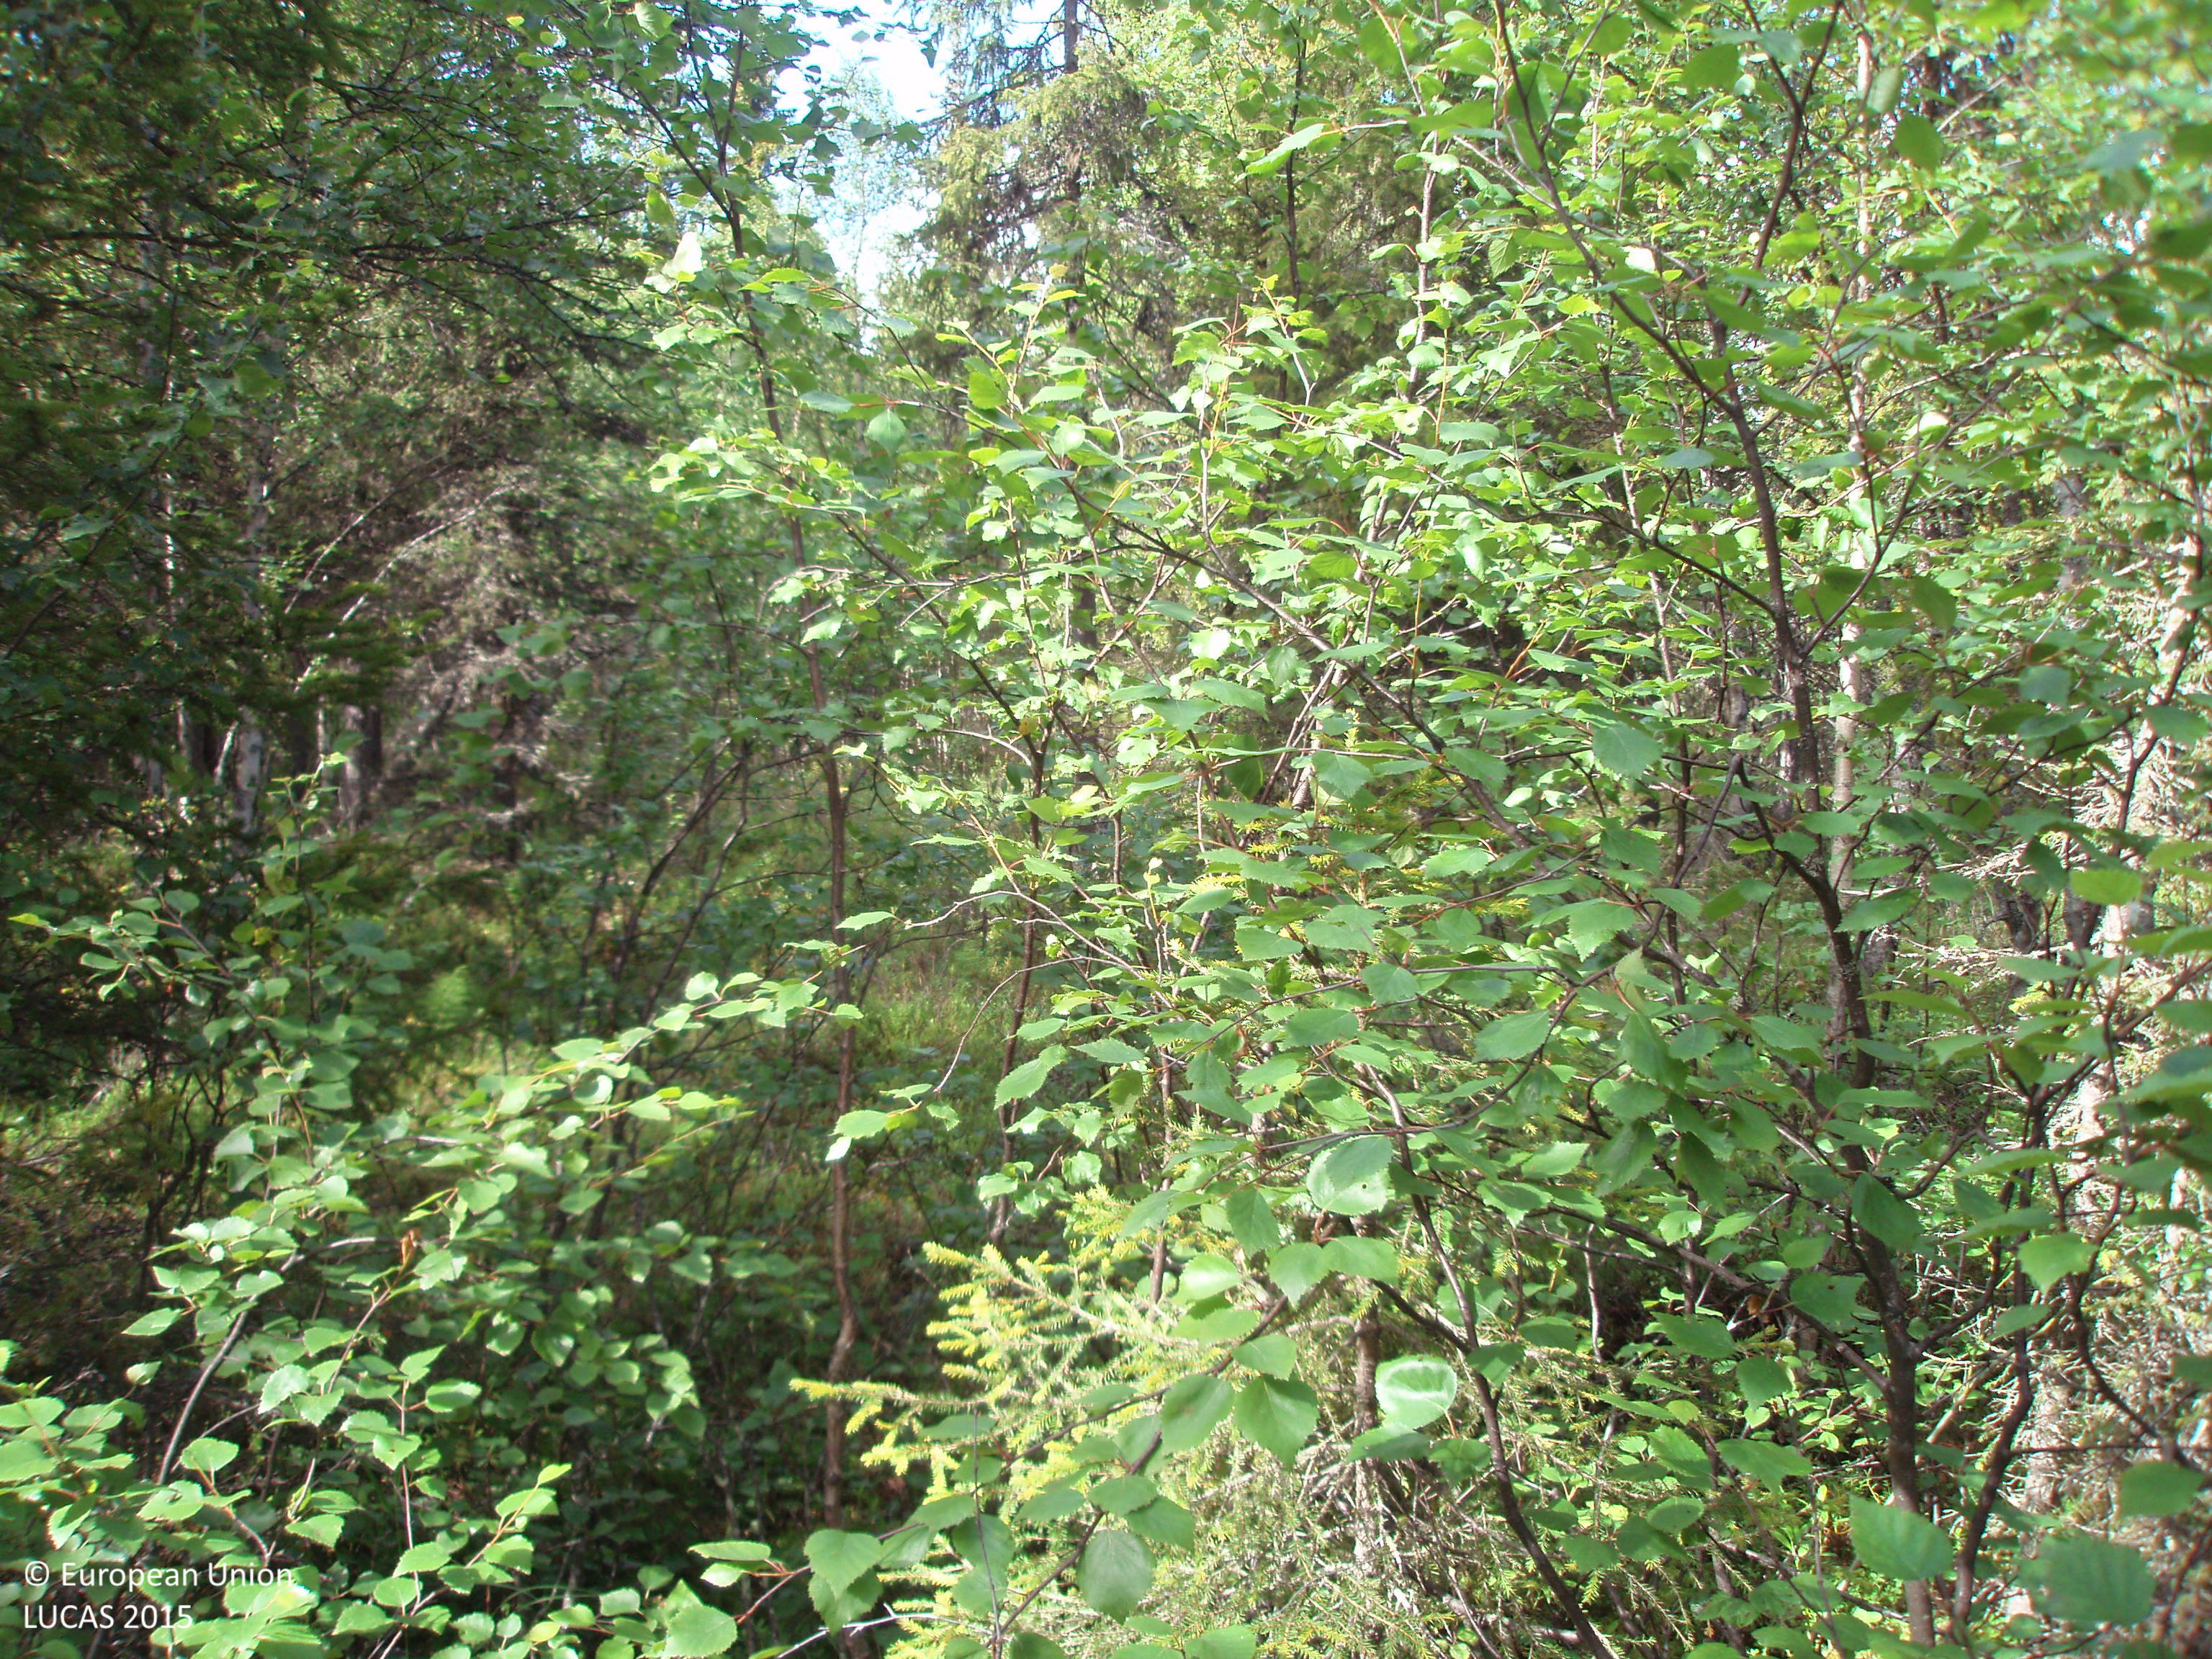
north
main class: Woodland
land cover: Other mixed woodland
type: boreal forest
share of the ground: > 75 %
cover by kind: coniferous forest trees 45 %, broadleaved forest trees 40 %, shrubs 15 %
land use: Forestry
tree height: > 5 m
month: July
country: FI
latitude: 66.9322
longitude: 28.5987
